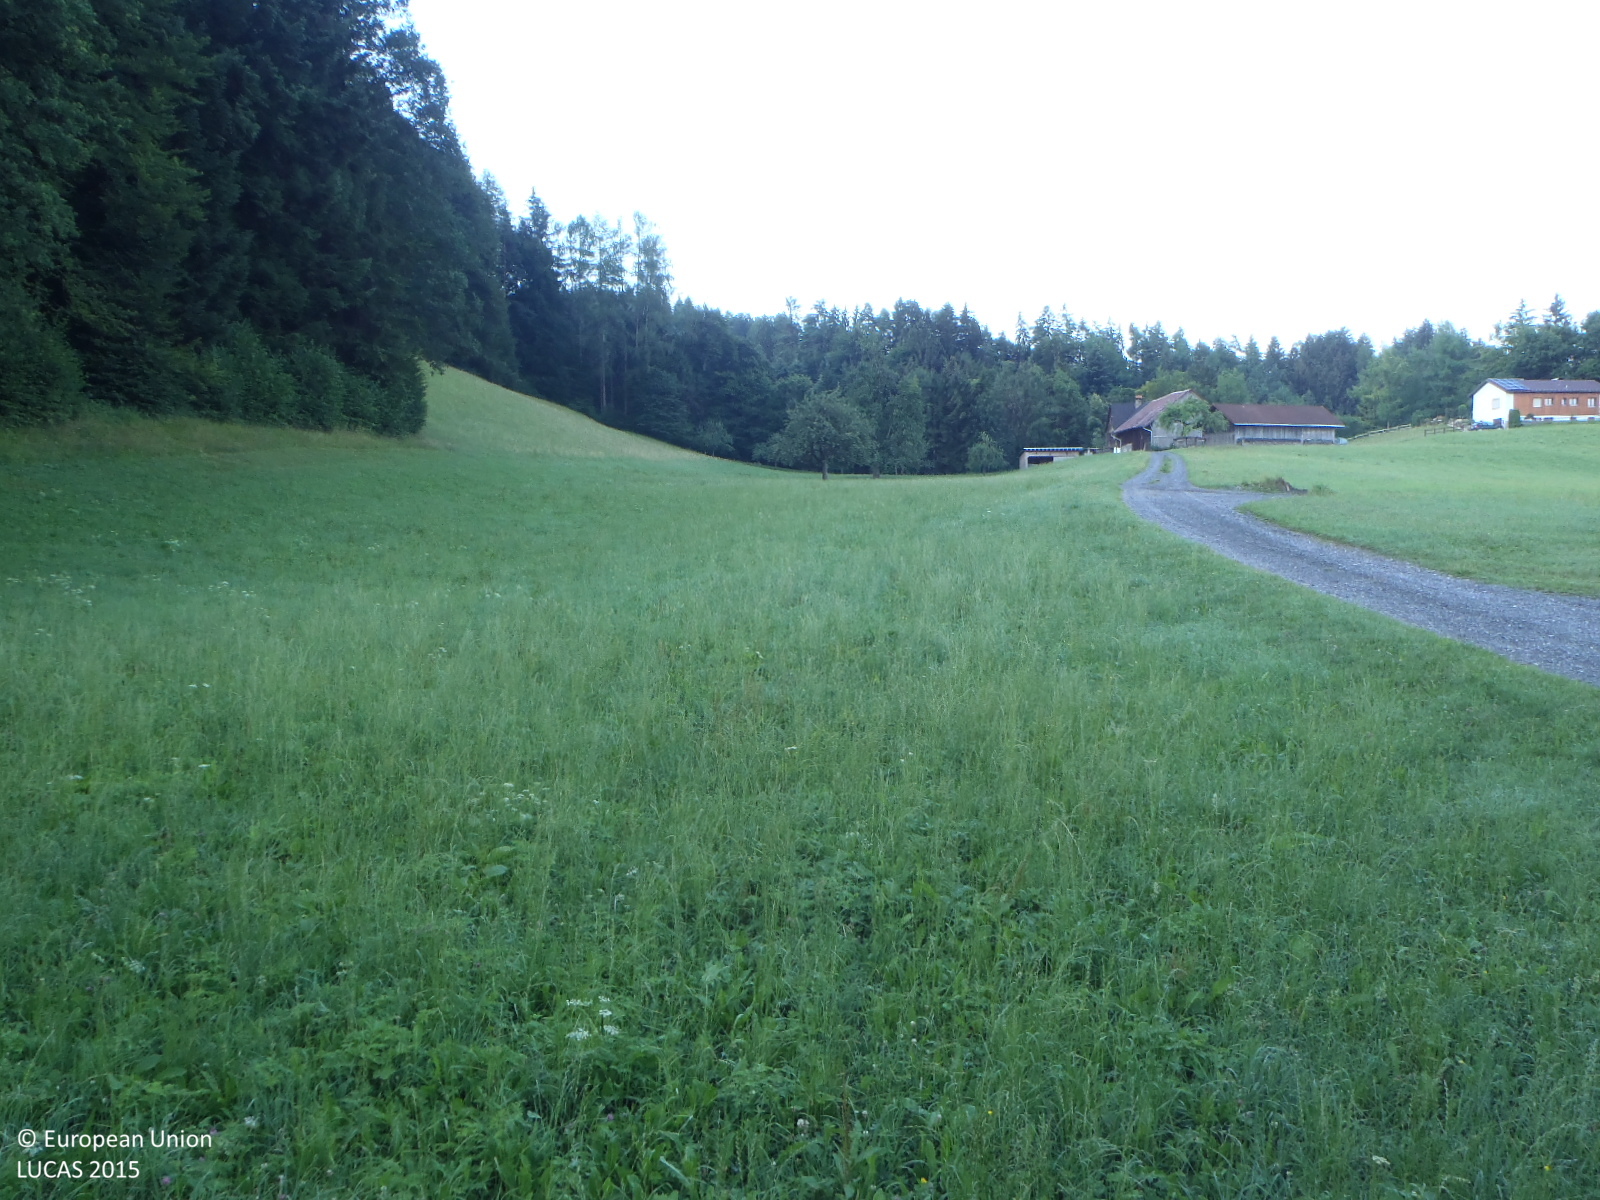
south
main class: Grassland
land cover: Grassland without tree/shrub cover
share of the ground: > 75 %
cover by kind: herbaceous plants 100 %
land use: Agriculture (excluding fallow land and kitchen gardens)
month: July
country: AT
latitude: 47.2871
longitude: 9.6698
